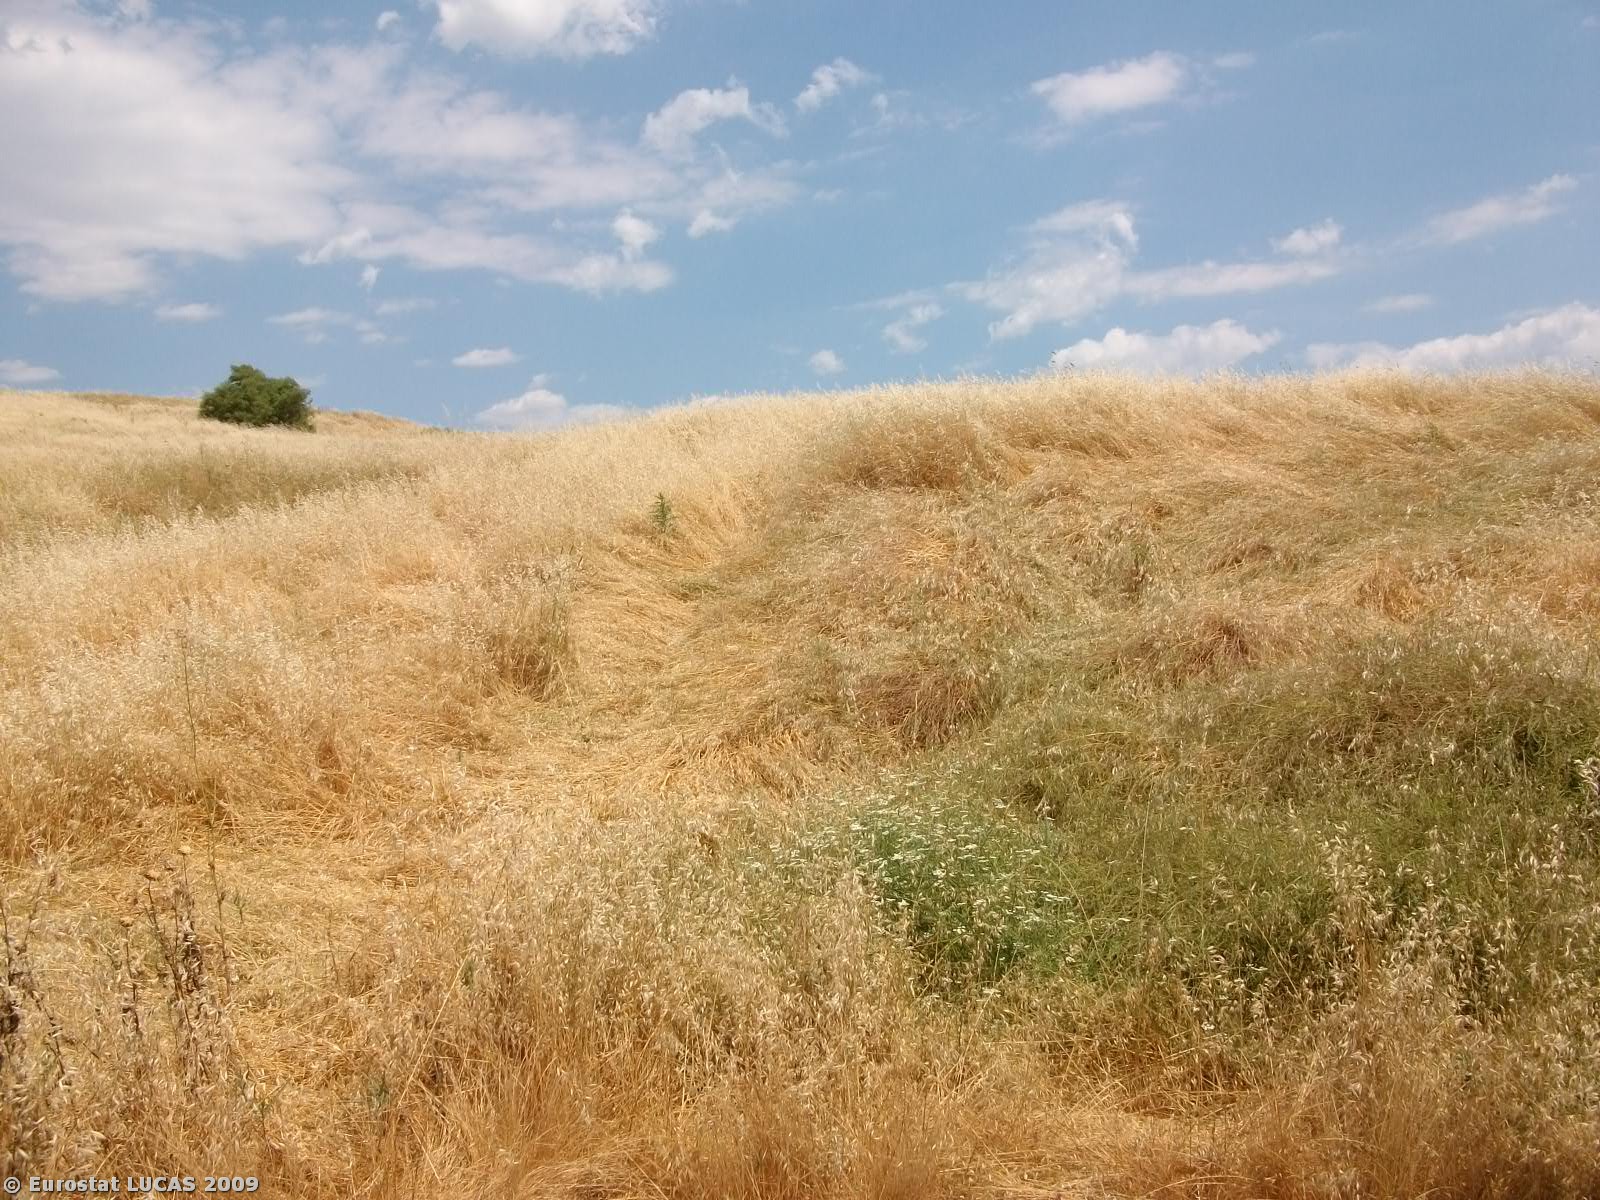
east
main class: Woodland
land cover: Broadleaved woodland
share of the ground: 50 - 75 %
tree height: > 5 m
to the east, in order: Broadleaved woodland; Other structural elements; Spontaneously vegetated surfaces; Tracks; Spontaneously vegetated surfaces; Tracks; Spontaneously vegetated surfaces
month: June
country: GR
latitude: 37.3987
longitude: 22.0566
